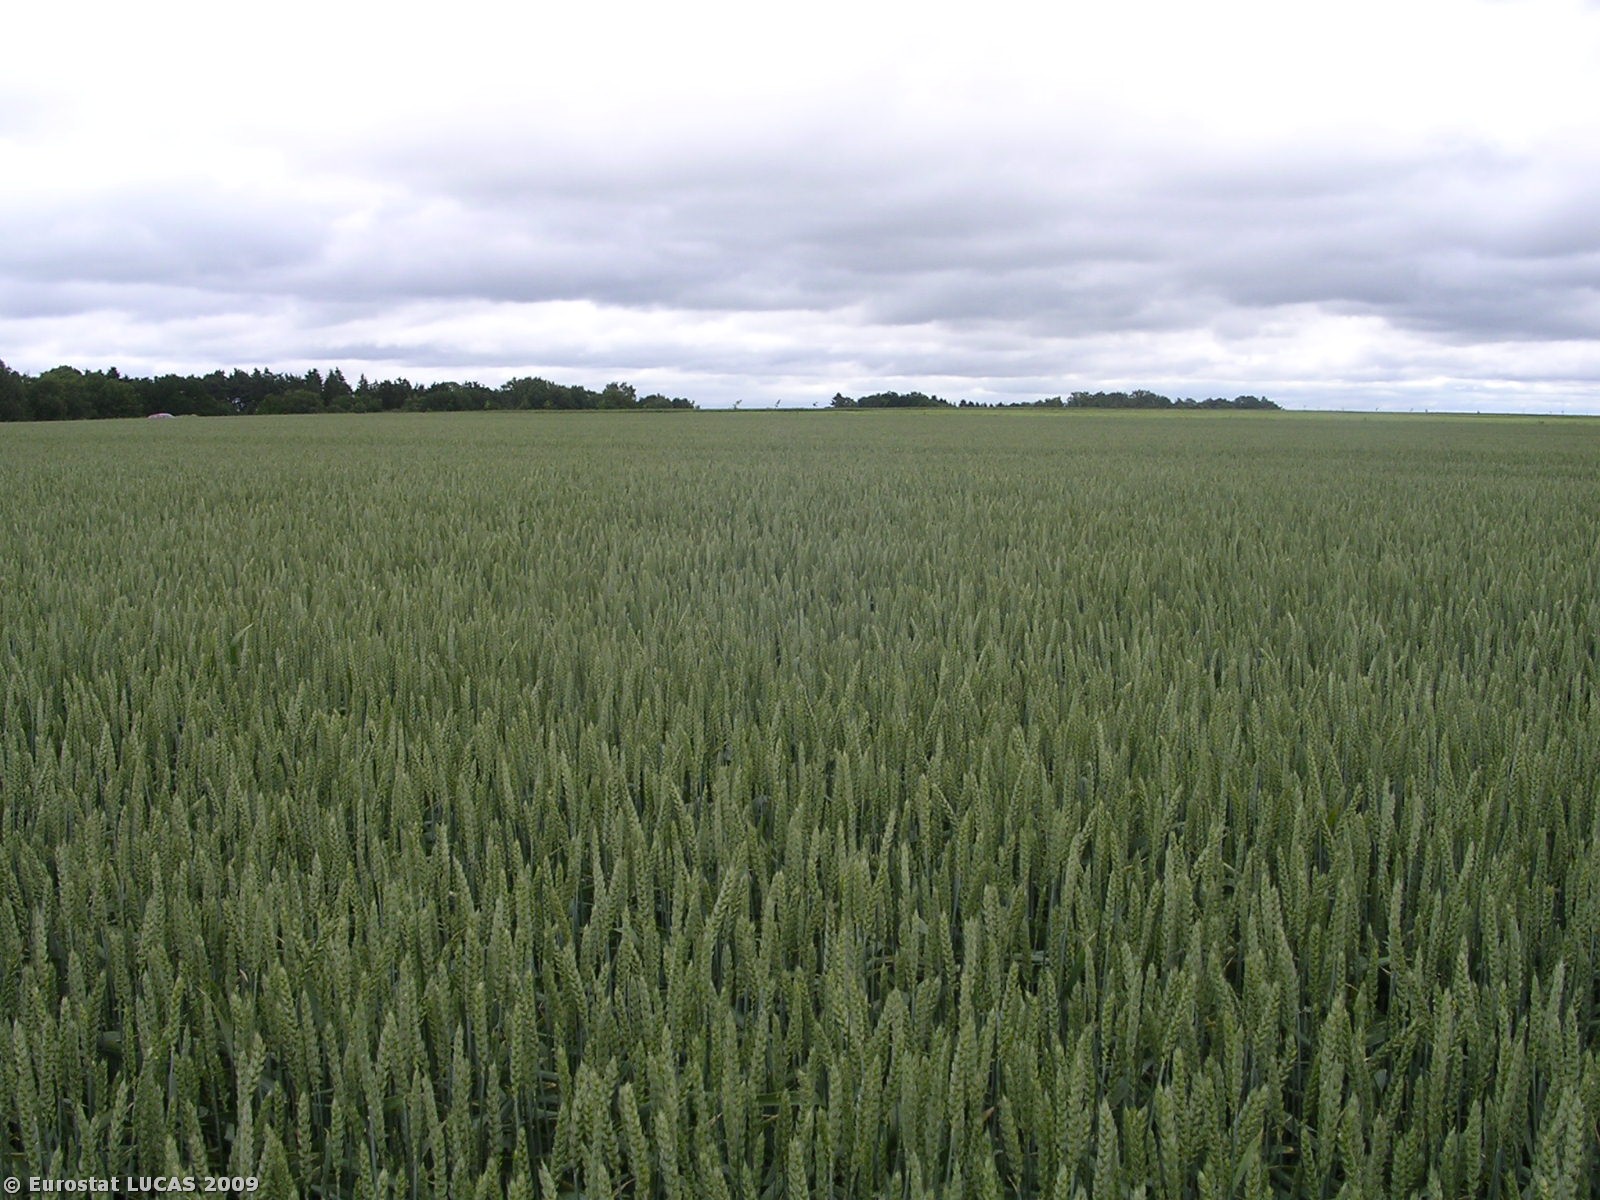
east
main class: Cropland
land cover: Common wheat
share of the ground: > 75 %
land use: Agriculture (excluding fallow land and kitchen gardens)
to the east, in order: Common wheat; Grassland without tree/shrub cover; Tracks; Grass margins; Barley
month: June
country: CZ
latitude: 50.4480
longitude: 14.6917
